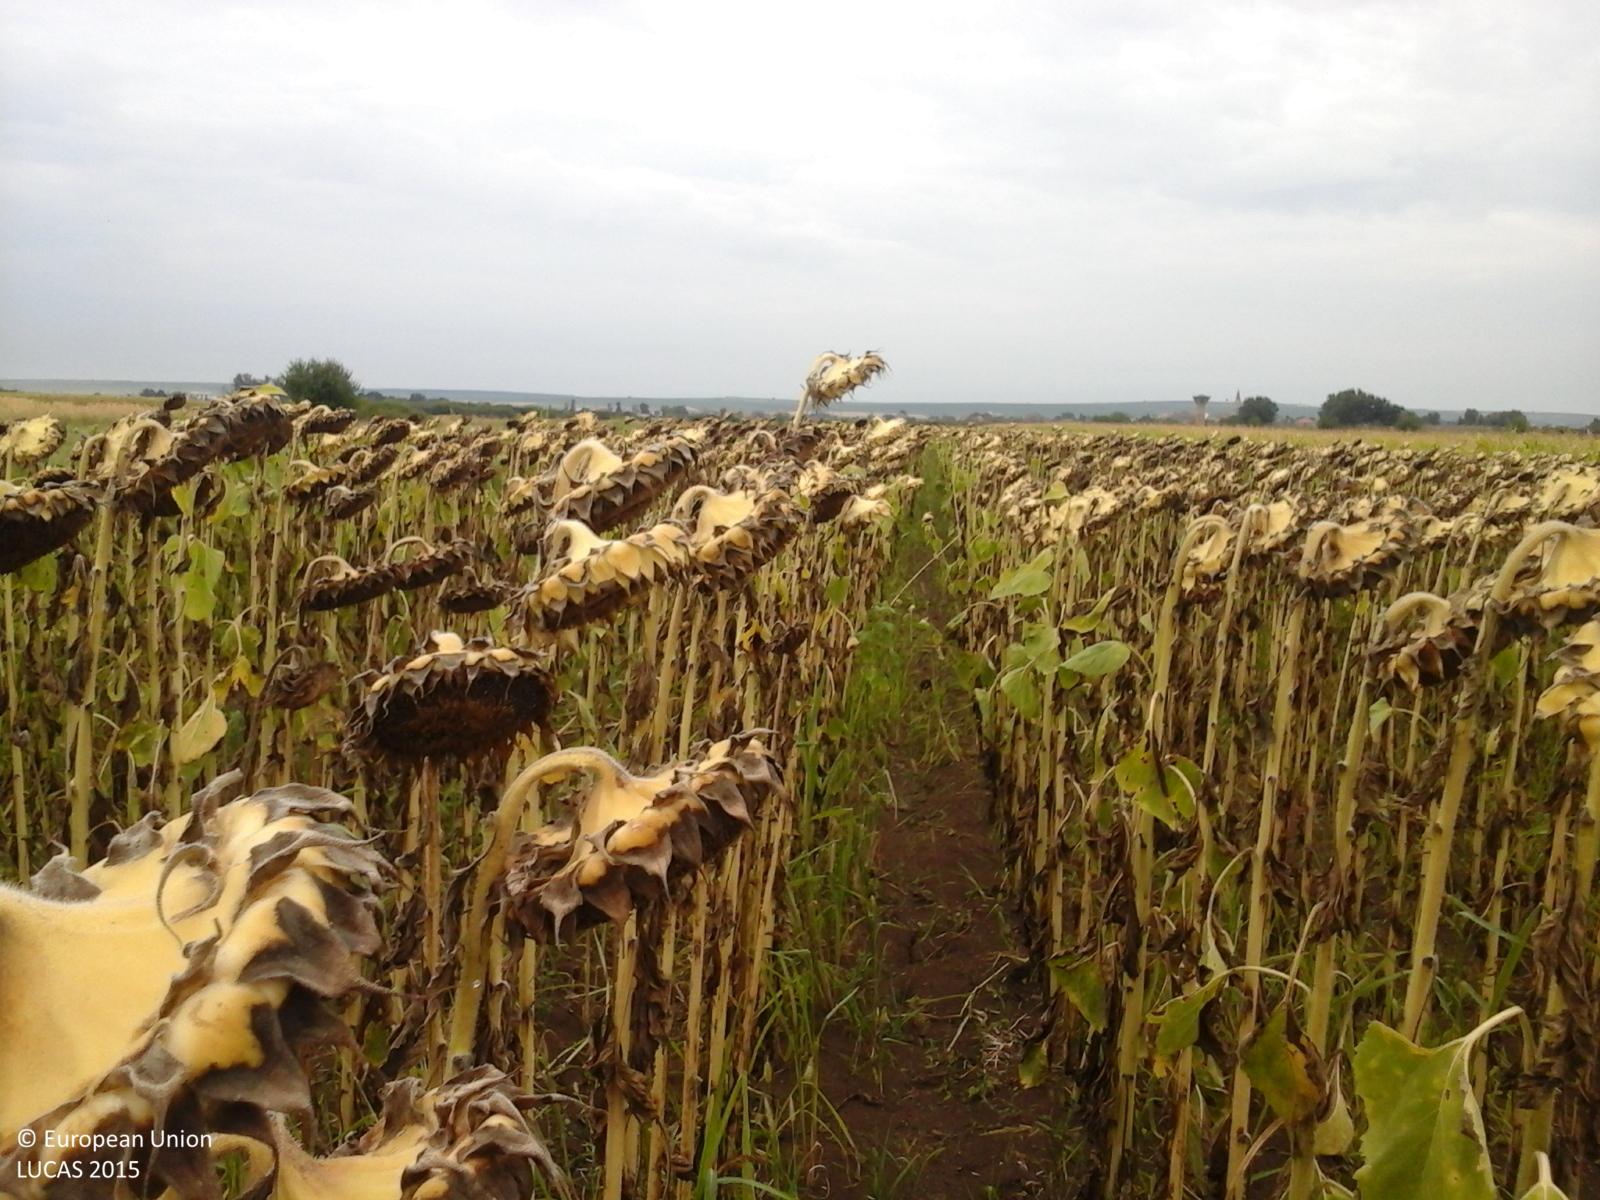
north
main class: Cropland
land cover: Sunflower
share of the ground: > 75 %
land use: Agriculture (excluding fallow land and kitchen gardens)
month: August
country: RO
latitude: 45.7839
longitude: 21.4943
